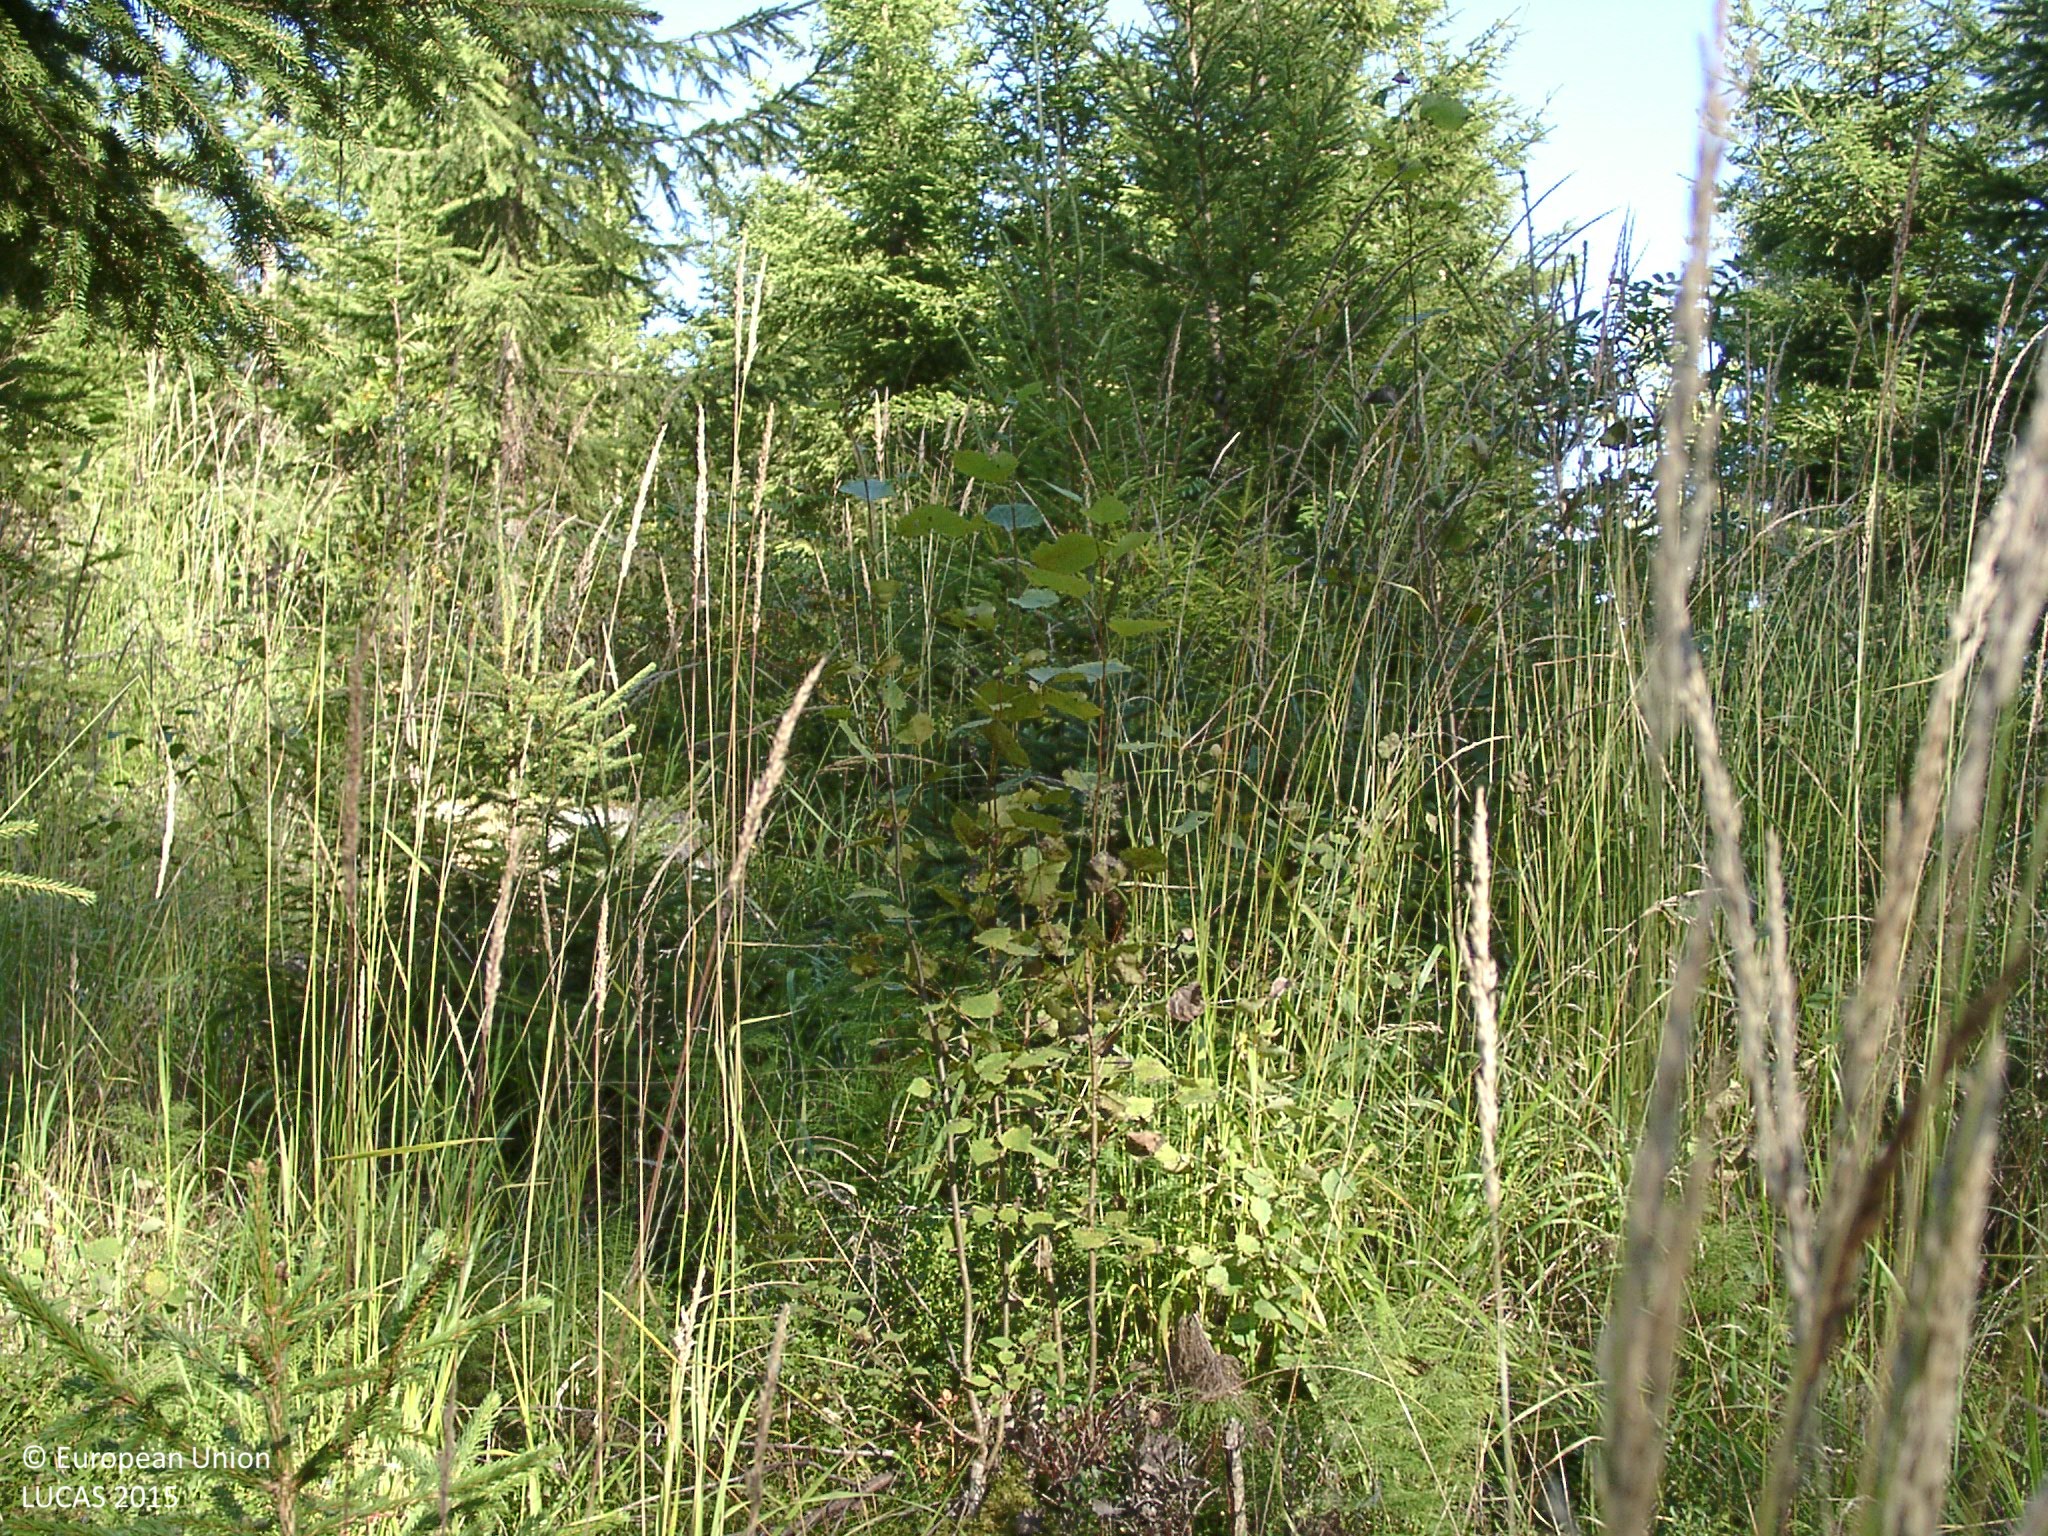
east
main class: Grassland
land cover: Grassland with sparse tree/shrub cover
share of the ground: > 75 %
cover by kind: herbaceous plants 90 %, coniferous forest trees 5 %, shrubs 5 %
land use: Forestry
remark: Clear cut
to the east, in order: Grassland with sparse tree/shrub cover; Spruce dominated coniferous woodland; Spruce dominated mixed woodland; Tracks; Other coniferous woodland; Groves; Other coniferous woodland; Tracks; Shruby margins; Ditches and canals; Grass margins; Barley
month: August
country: FI
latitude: 61.9087
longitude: 25.0119
